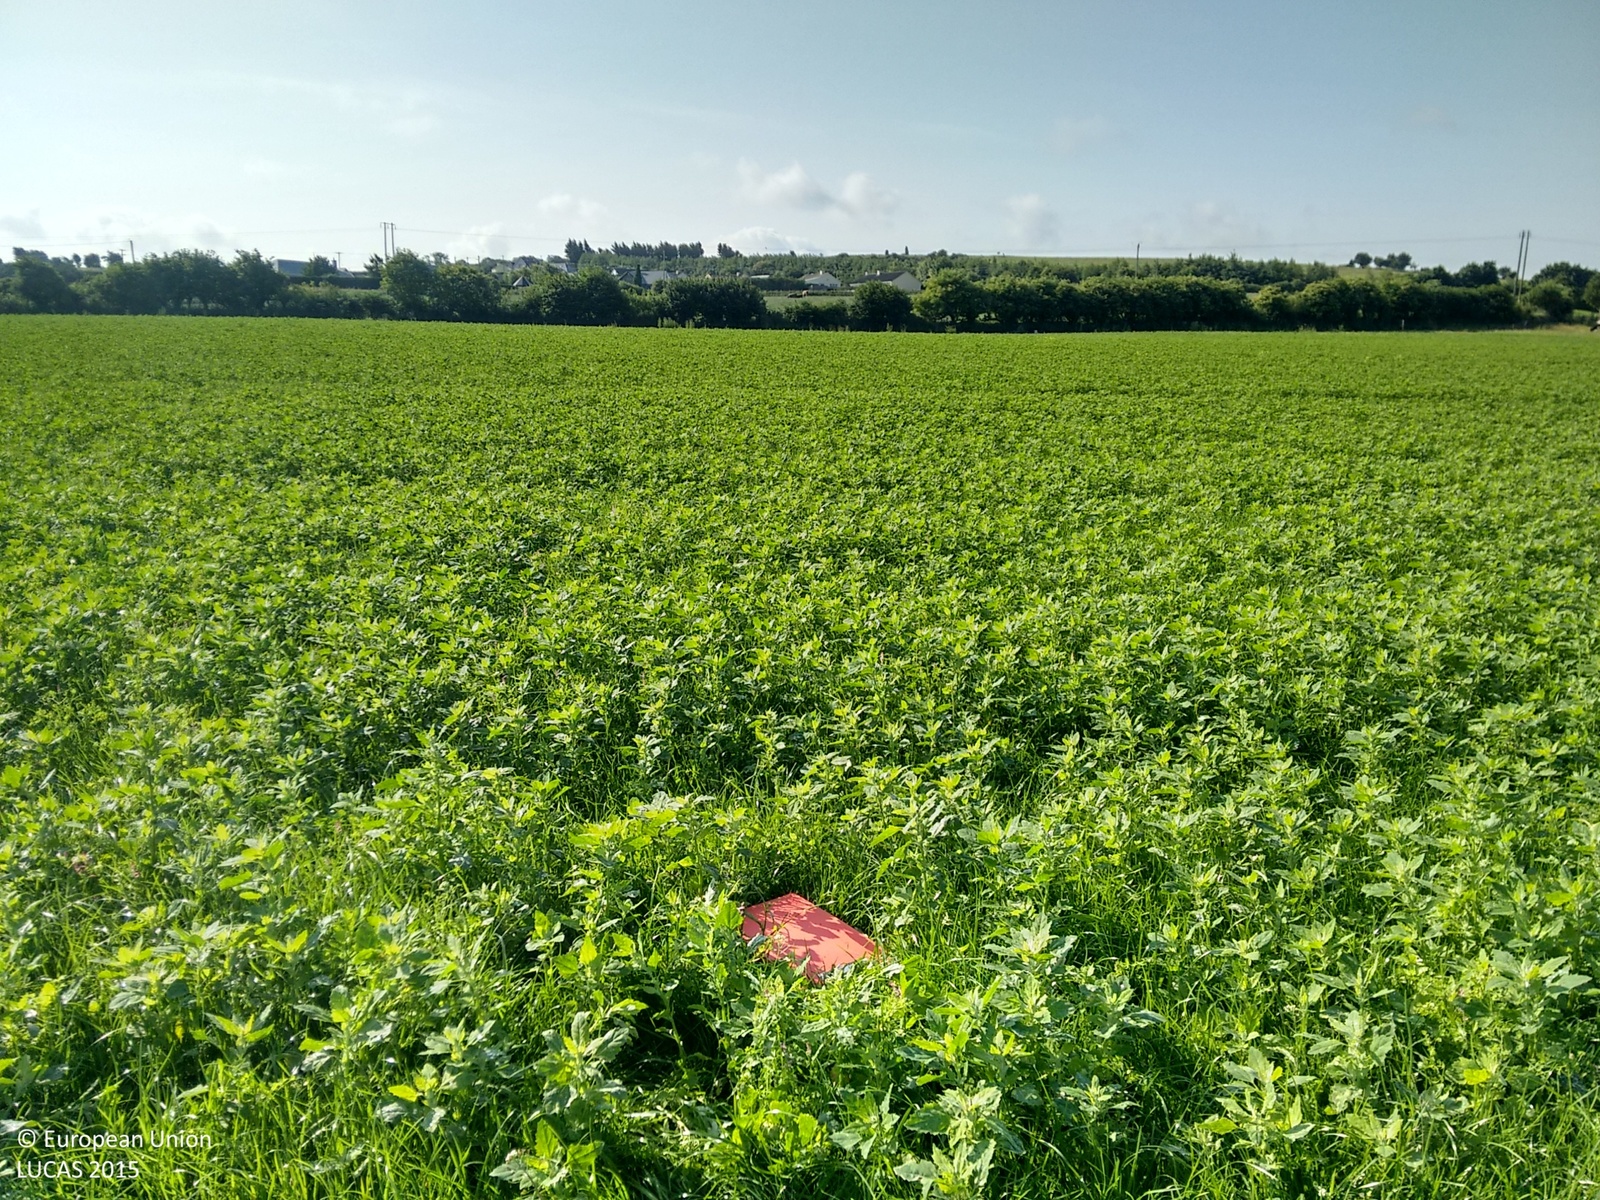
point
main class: Cropland
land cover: Temporary grasslands
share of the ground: > 75 %
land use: Agriculture (excluding fallow land and kitchen gardens)
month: July
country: IE
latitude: 52.5782
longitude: -7.7122
